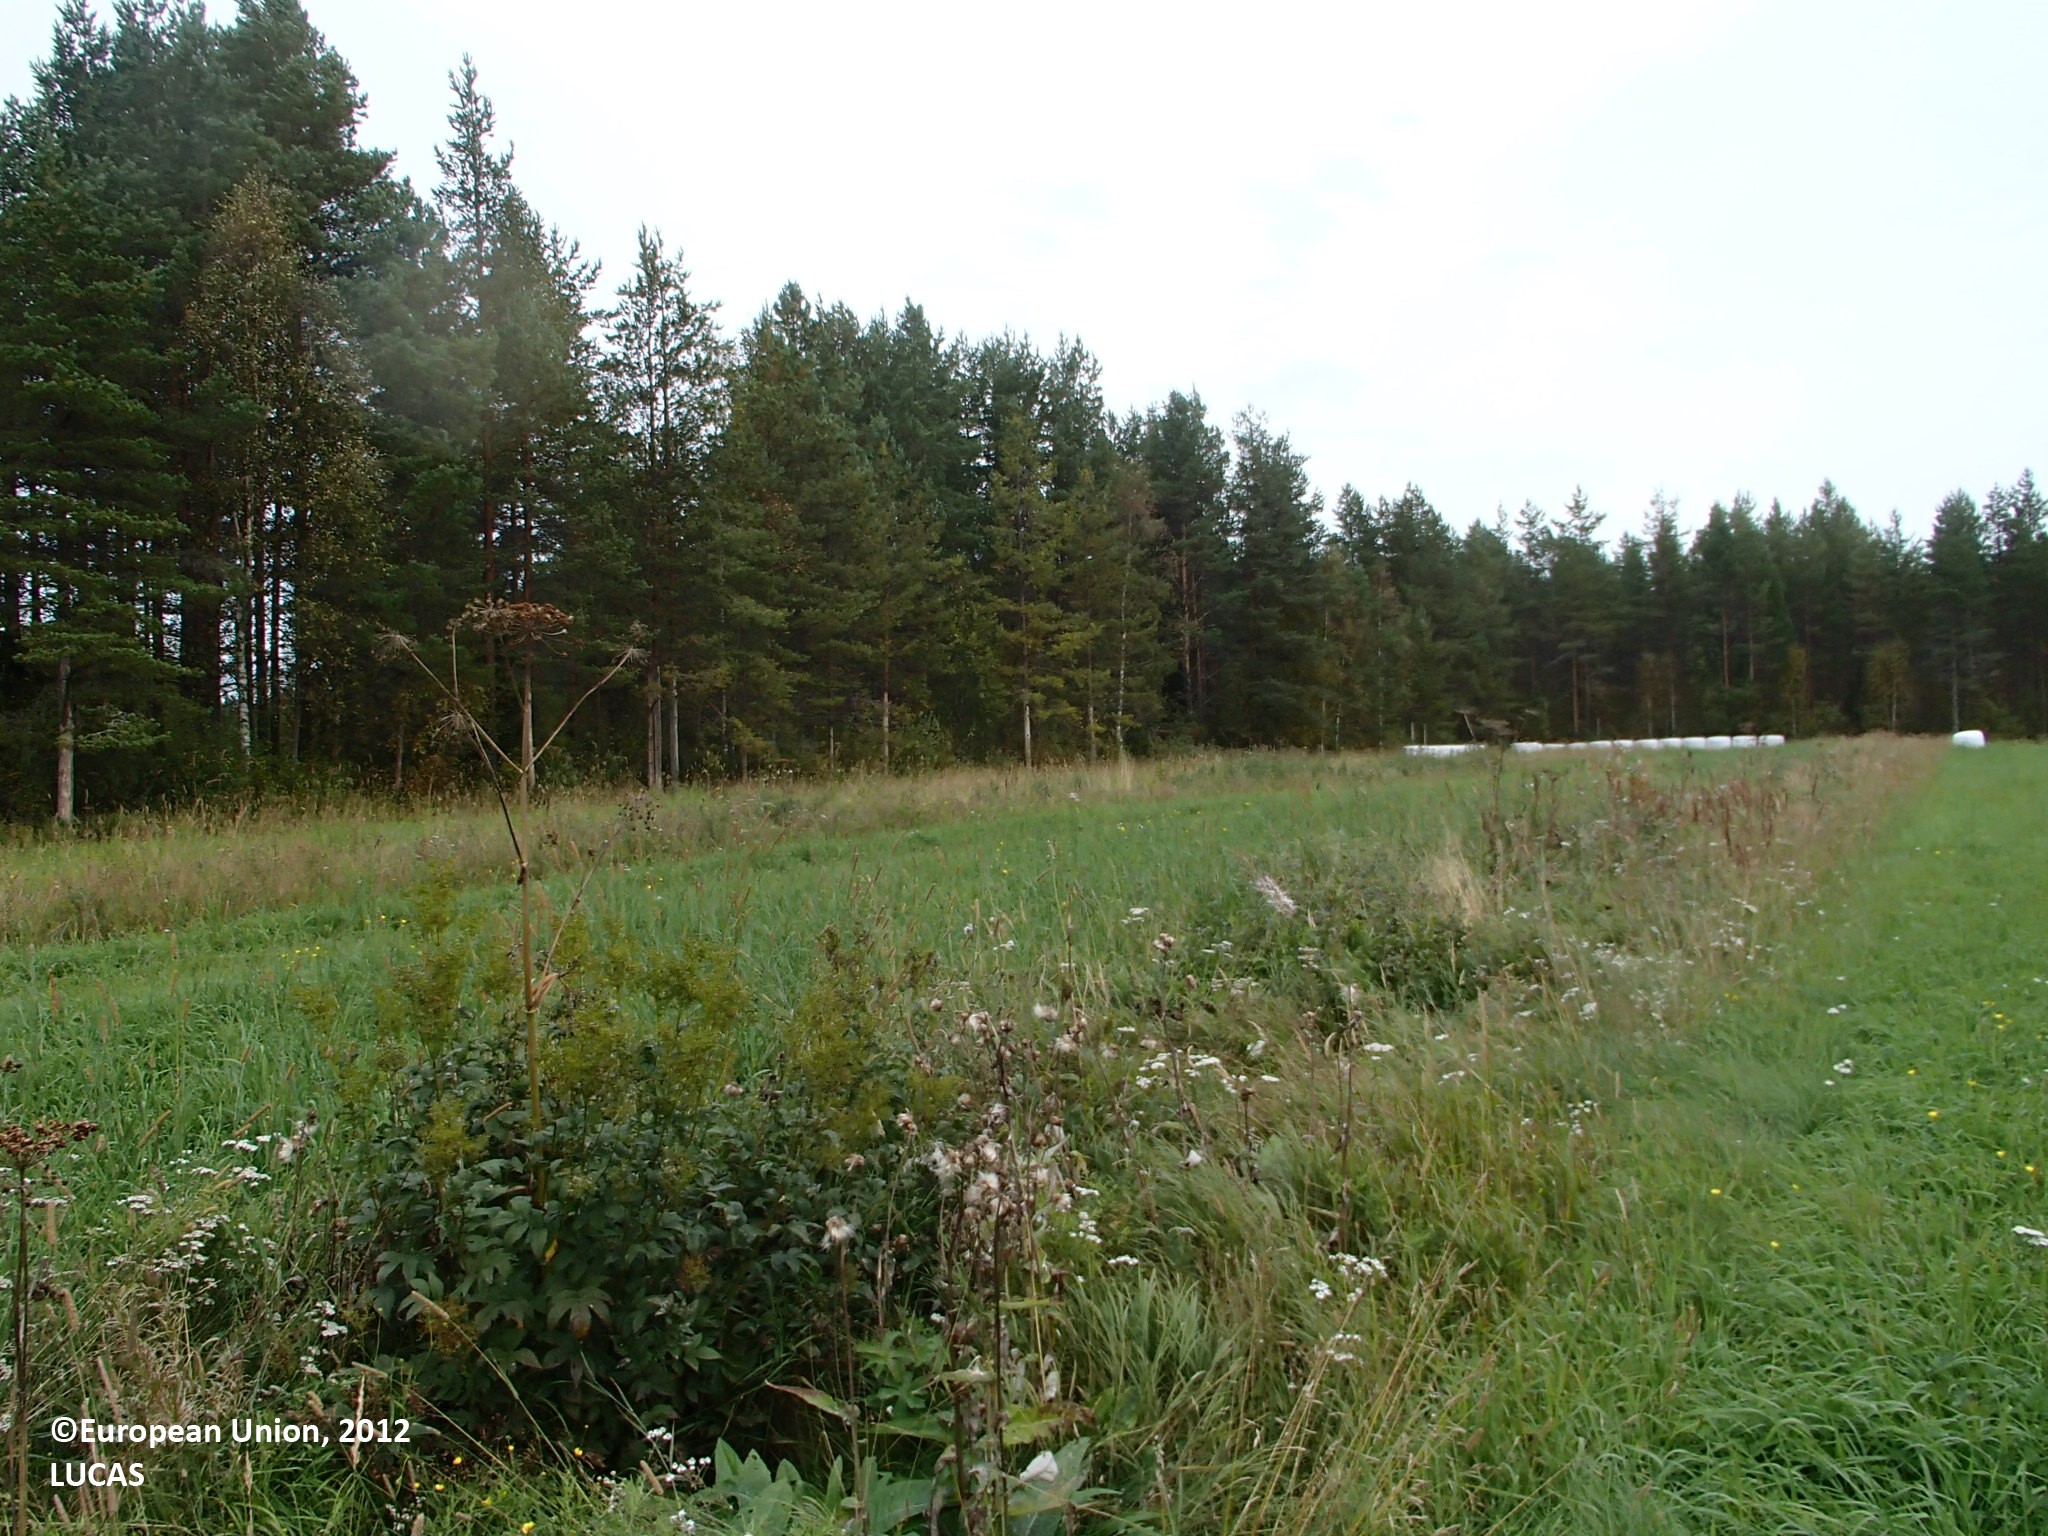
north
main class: Cropland
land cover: Temporary grasslands
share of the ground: > 75 %
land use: Agriculture (excluding fallow land and kitchen gardens)
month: September
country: FI
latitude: 63.8080
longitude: 25.9271
